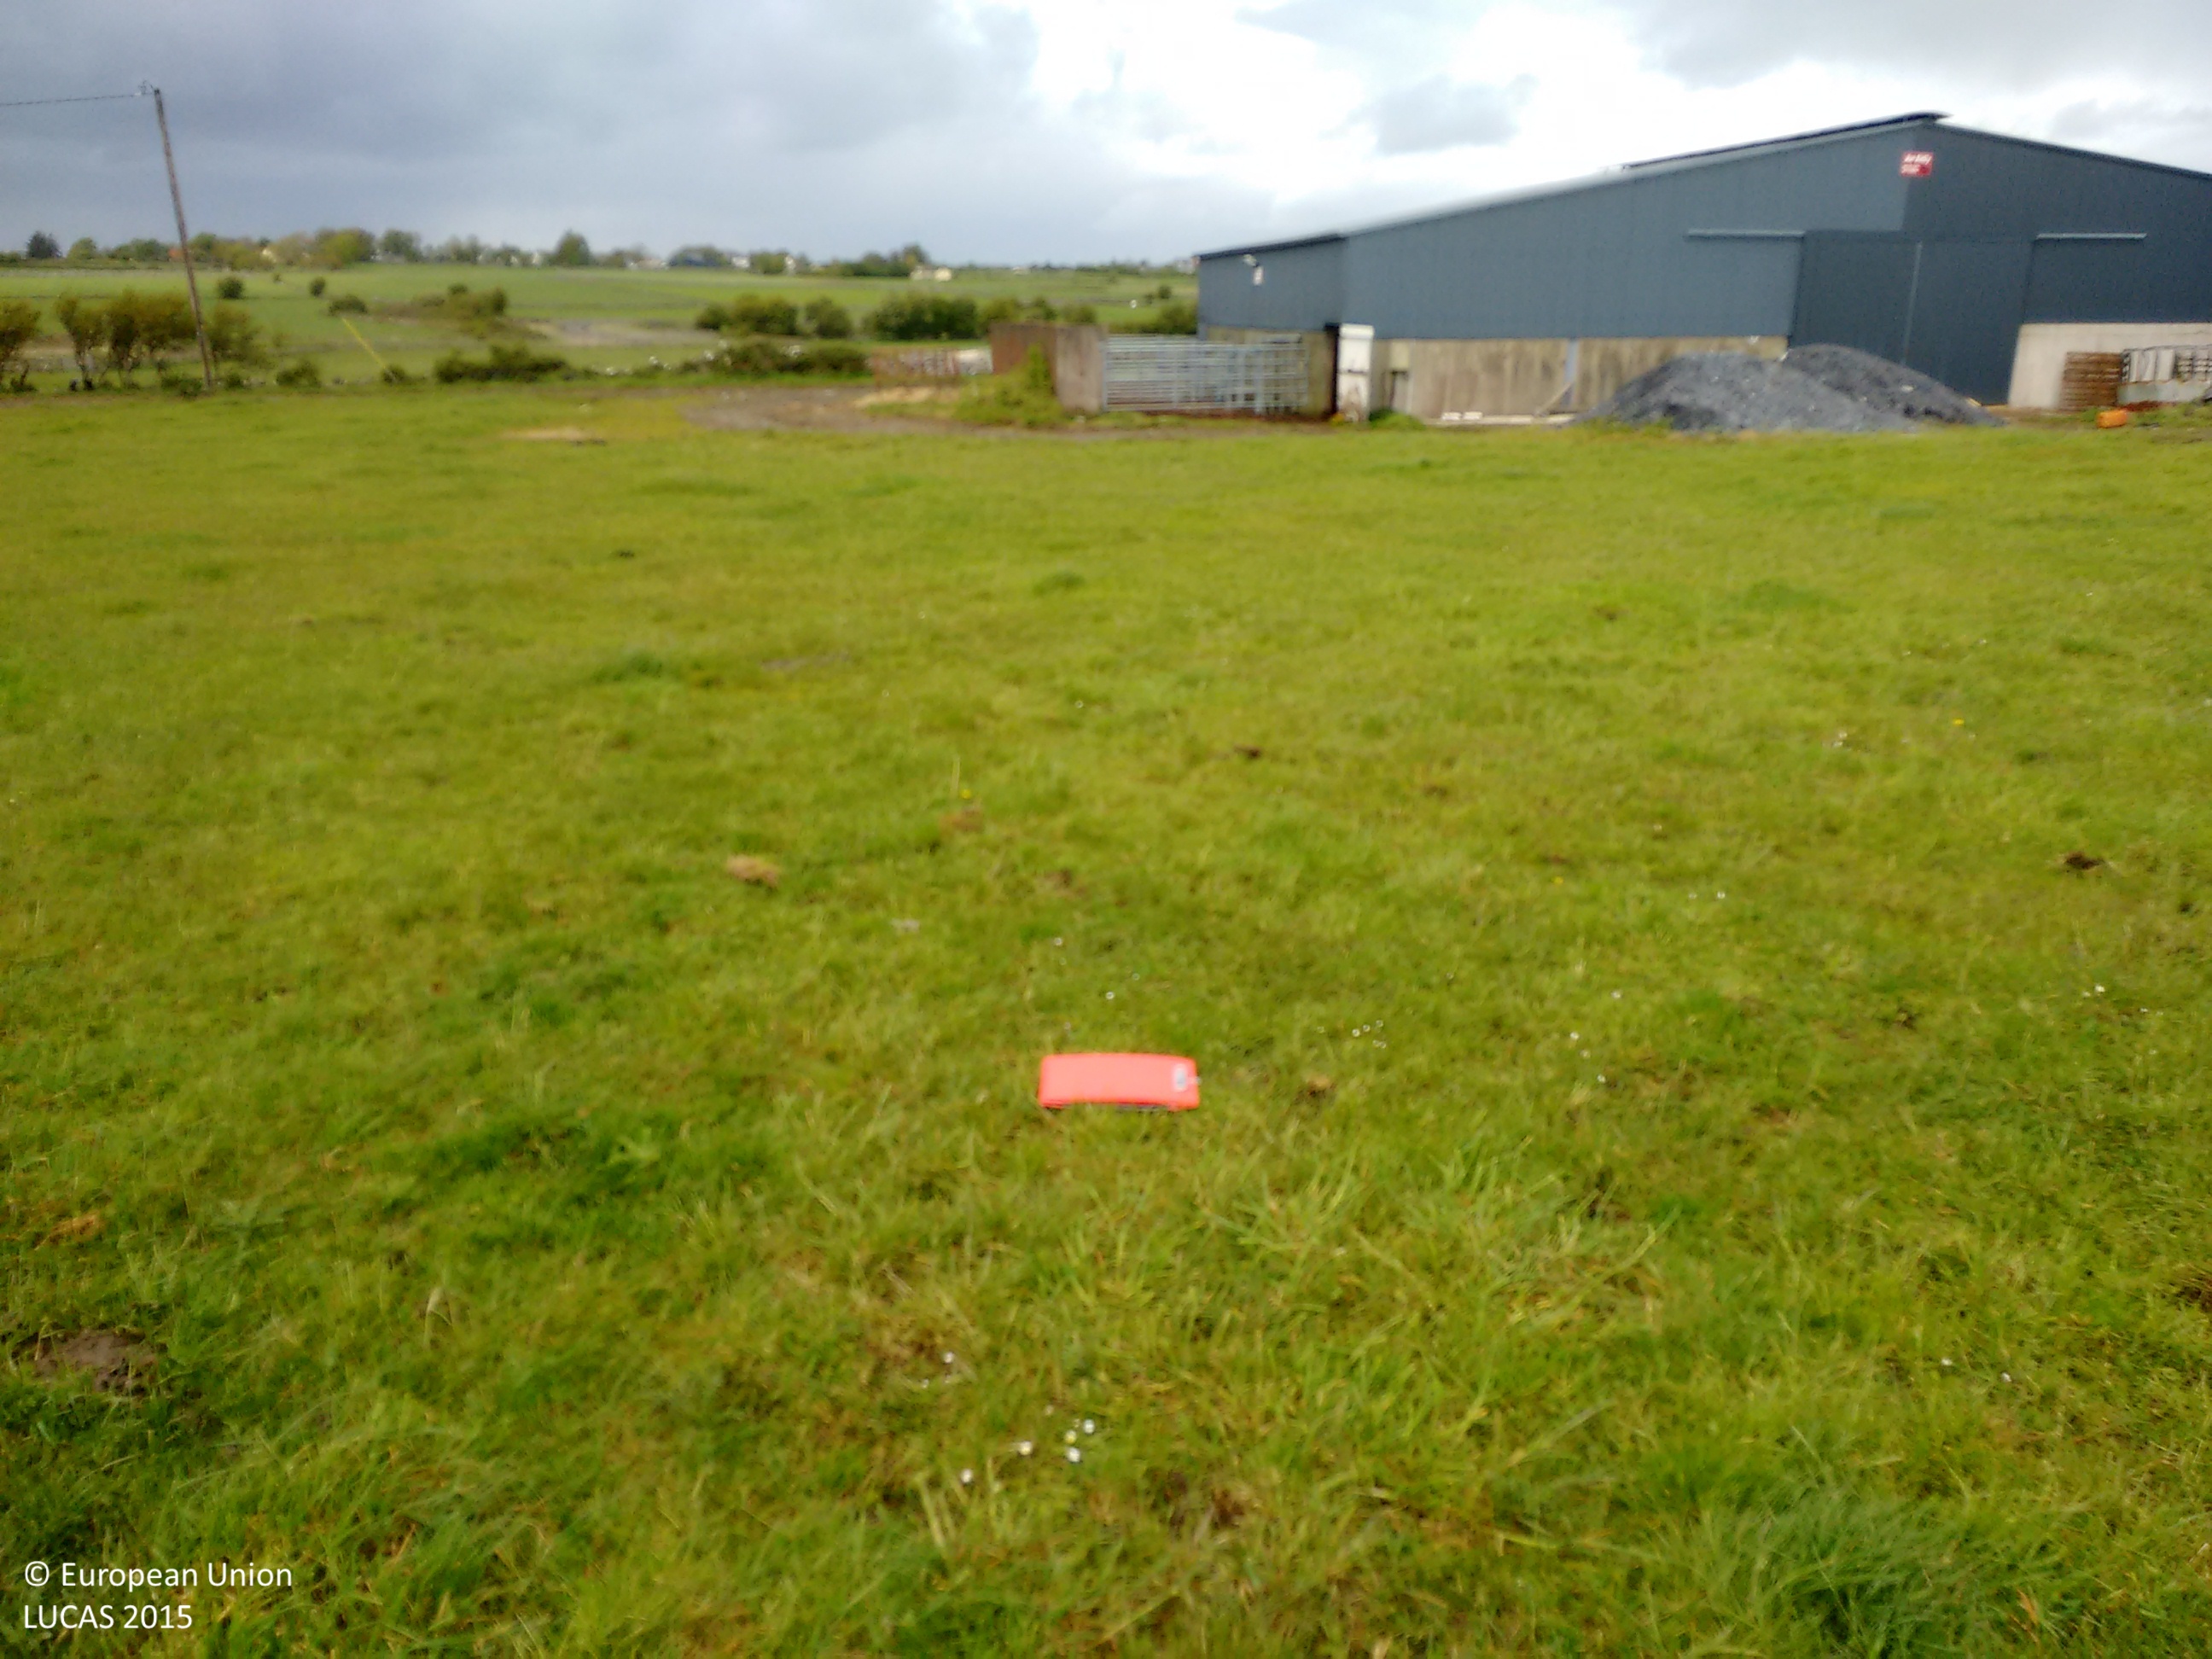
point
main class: Grassland
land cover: Grassland without tree/shrub cover
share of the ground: > 75 %
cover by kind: herbaceous plants 95 %, consolidated bare surface 5 %
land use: Agriculture (excluding fallow land and kitchen gardens)
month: May
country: IE
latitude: 53.2961
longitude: -8.9188
